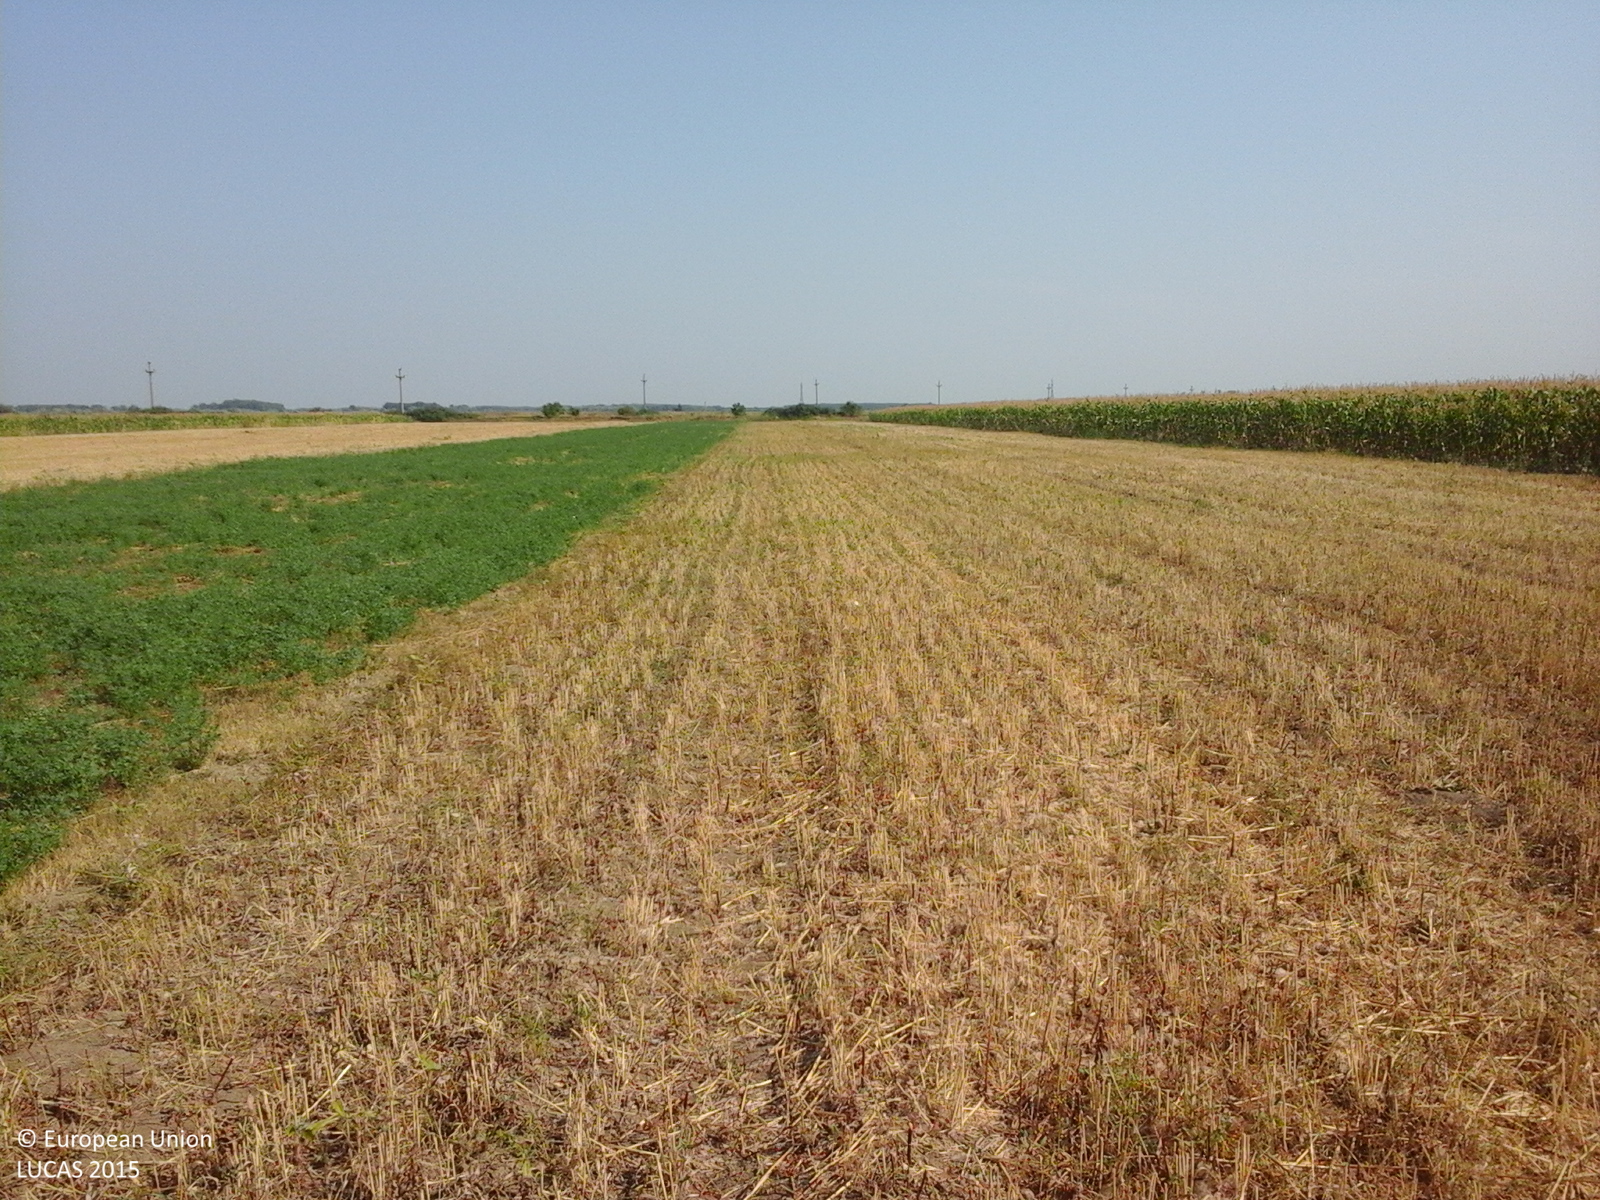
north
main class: Cropland
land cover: Common wheat
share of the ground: > 75 %
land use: Agriculture (excluding fallow land and kitchen gardens)
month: August
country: RO
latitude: 45.1532
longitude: 27.3819
